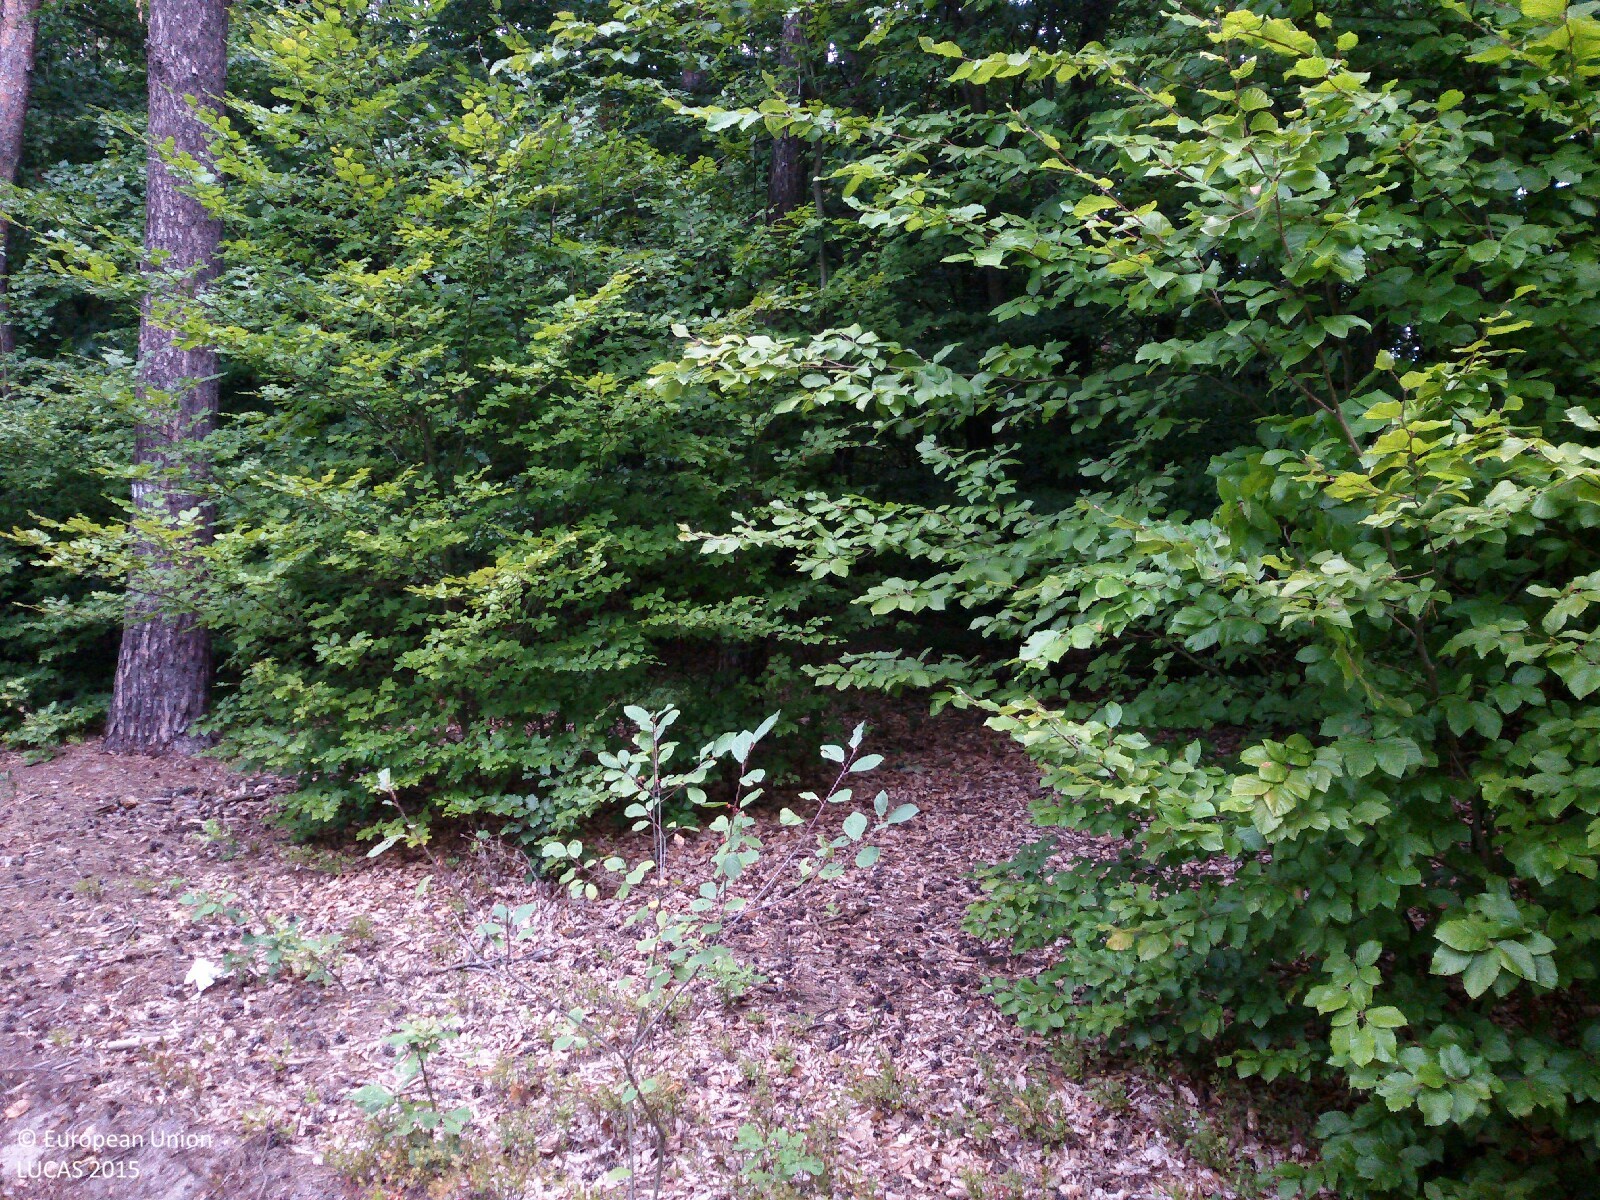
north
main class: Woodland
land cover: Broadleaved woodland
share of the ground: > 75 %
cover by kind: broadleaved forest trees 75 %, shrubs 25 %
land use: Forestry
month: July
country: PL
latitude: 51.9385
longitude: 21.7348
